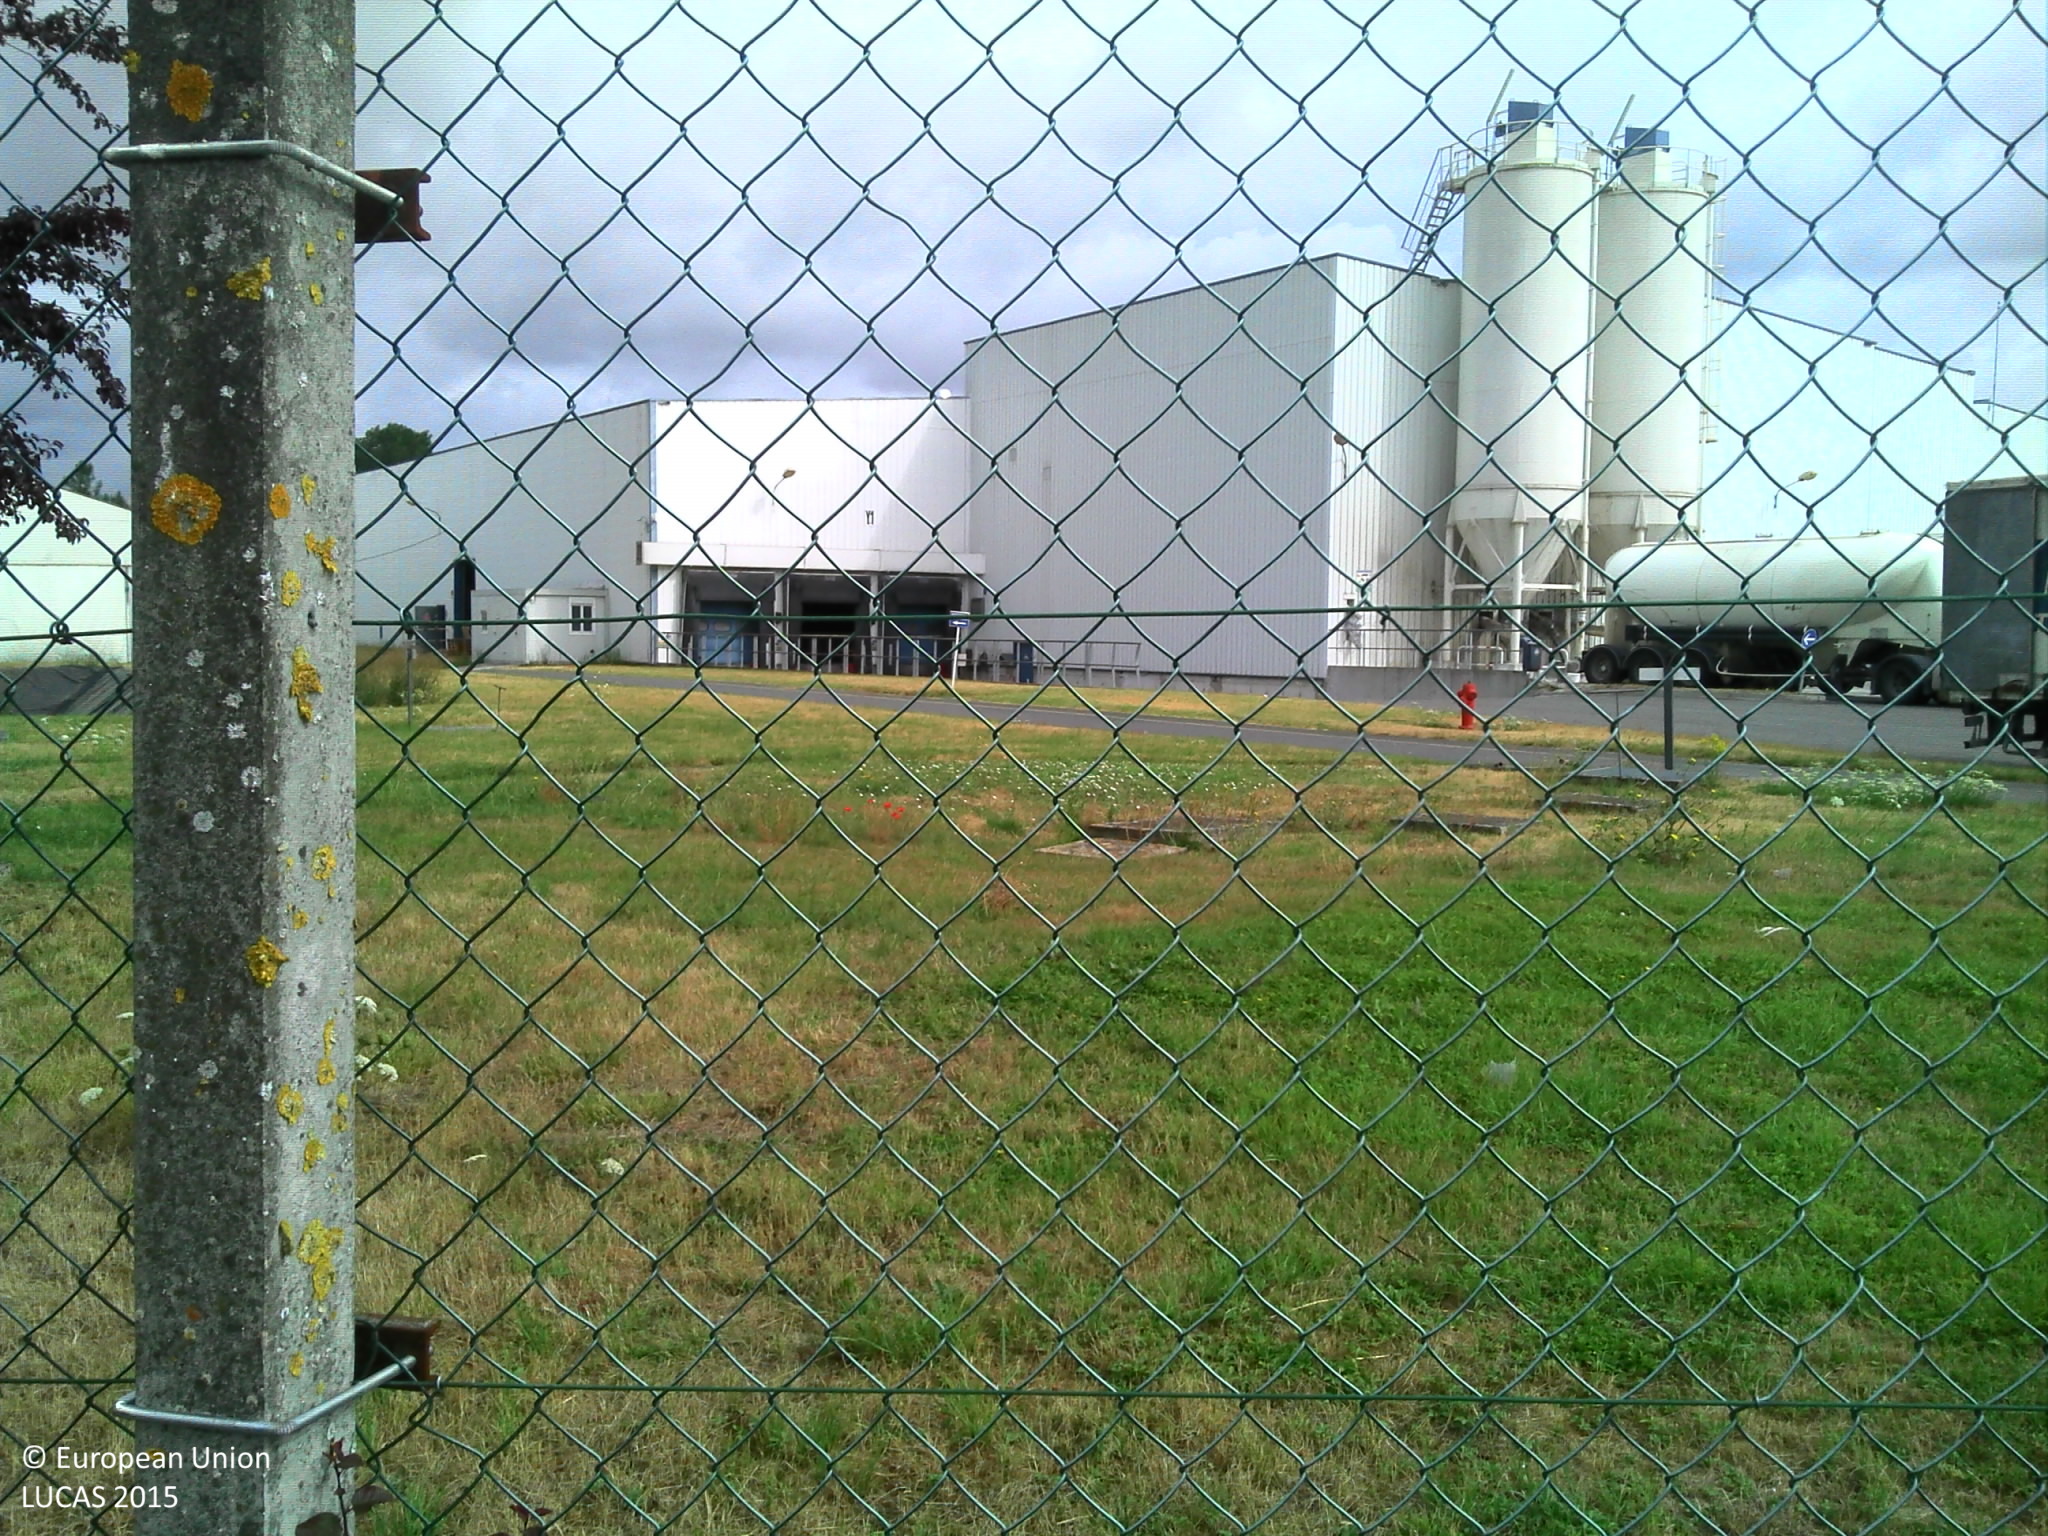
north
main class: Grassland
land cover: Grassland without tree/shrub cover
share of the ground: > 75 %
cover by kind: herbaceous plants 90 %, consolidated bare surface 10 %
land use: Logistics and storage
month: July
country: FR
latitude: 48.6678
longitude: 2.6984
